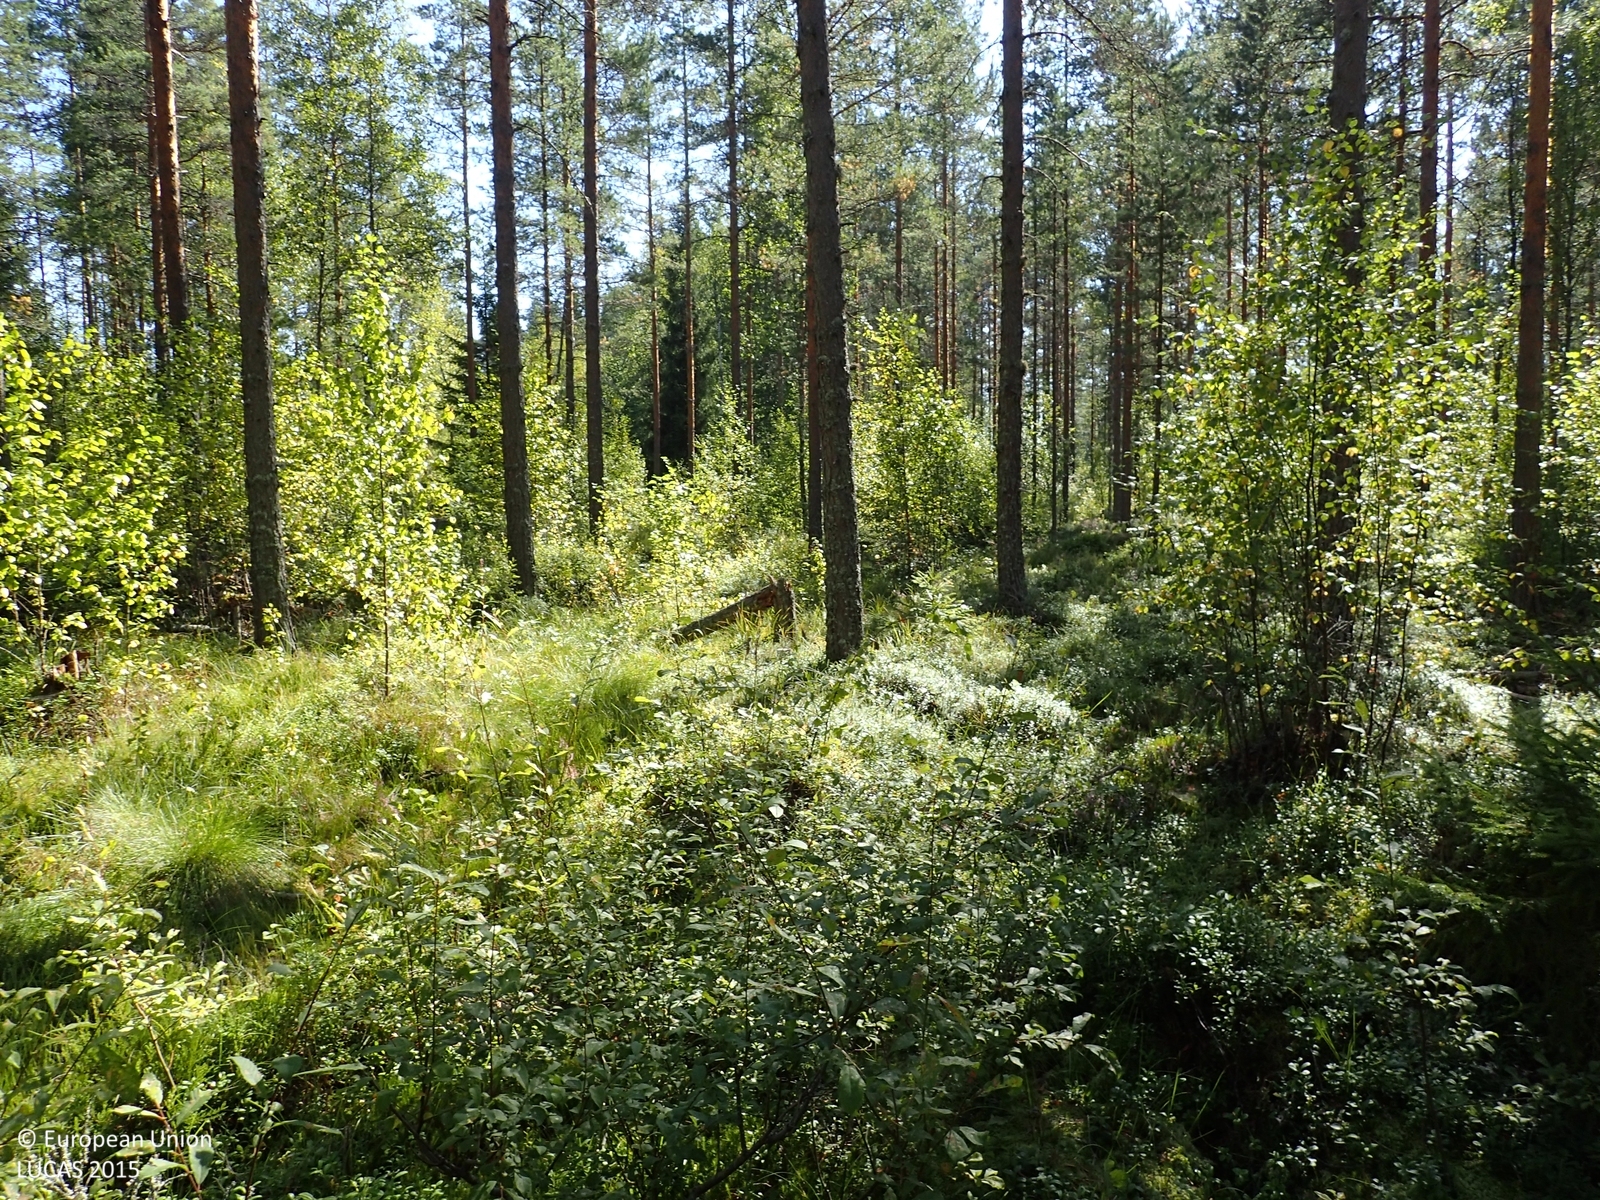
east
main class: Woodland
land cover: Pine dominated mixed woodland
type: boreal forest
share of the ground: > 75 %
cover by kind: coniferous forest trees 55 %, broadleaved forest trees 20 %, shrubs 20 %, herbaceous plants 5 %
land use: Forestry
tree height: > 5 m
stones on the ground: < 10 %
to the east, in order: Pine dominated mixed woodland; Ditches and canals; Pine dominated mixed woodland; Ditches and canals; Pine dominated mixed woodland; Ditches and canals; Pine dominated mixed woodland
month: August
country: FI
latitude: 62.5564
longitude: 21.9314
